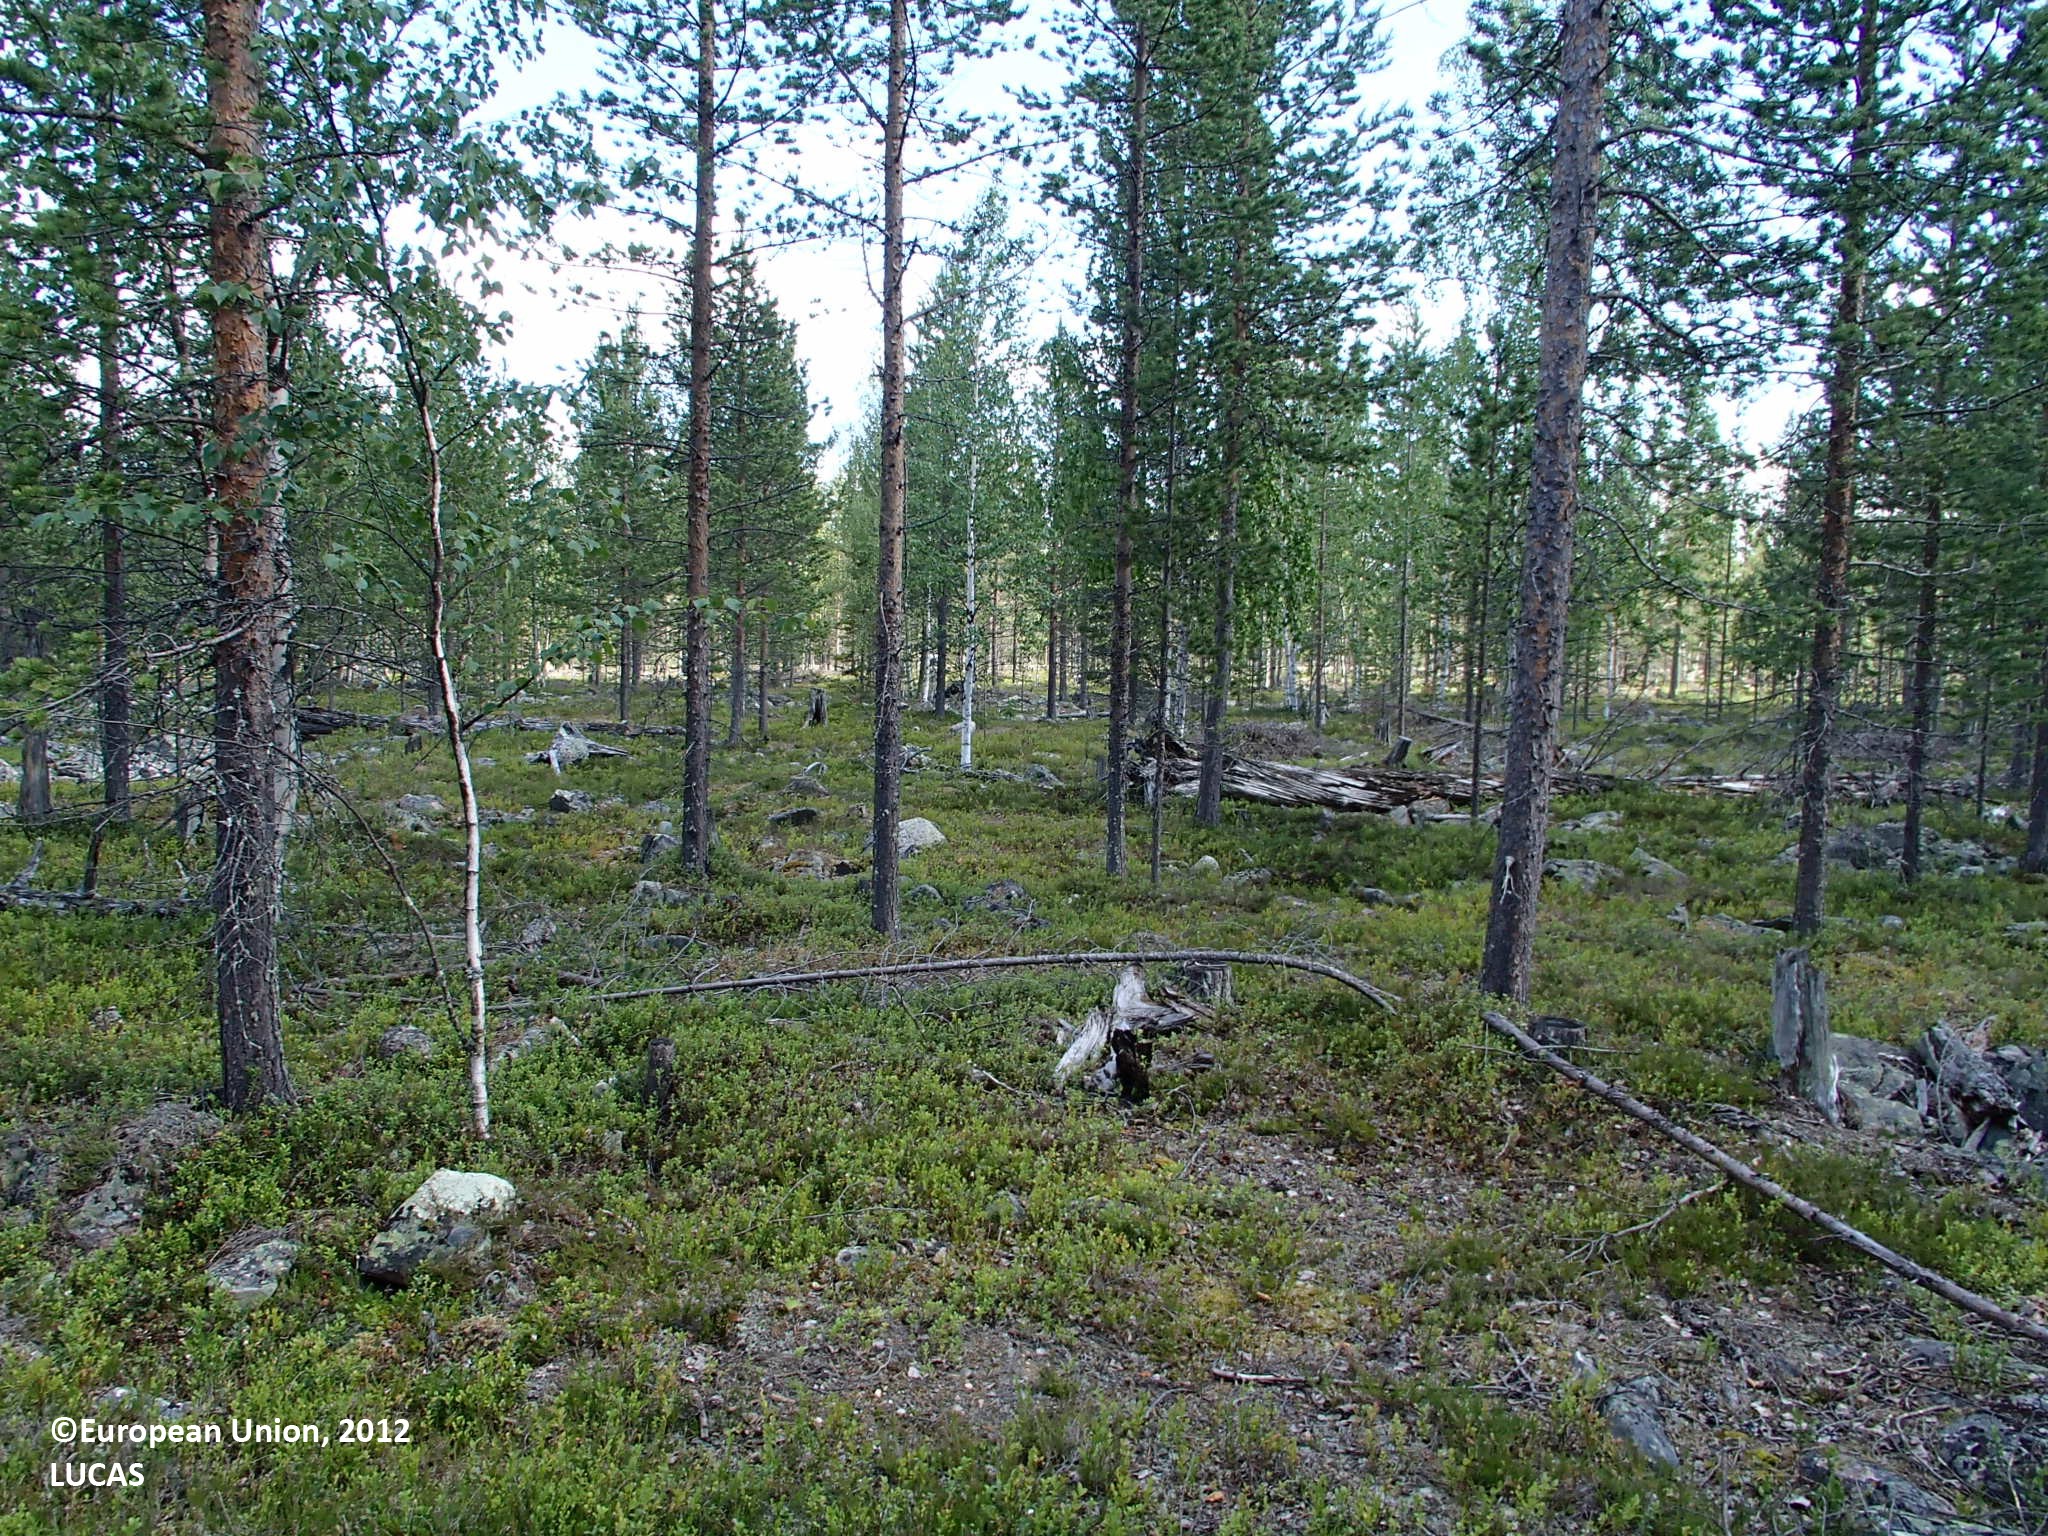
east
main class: Woodland
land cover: Pine dominated mixed woodland
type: boreal forest
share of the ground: 25 - 50 %
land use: Forestry
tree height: > 5 m
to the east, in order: Pine dominated mixed woodland; Other mixed woodland; Ditches and canals; Grass margins; Paved roads, cycling and walking lanes; Other bare soil; Ditches and canals; Other mixed woodland; Pine dominated coniferous woodland
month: July
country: FI
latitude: 67.1804
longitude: 25.5592
